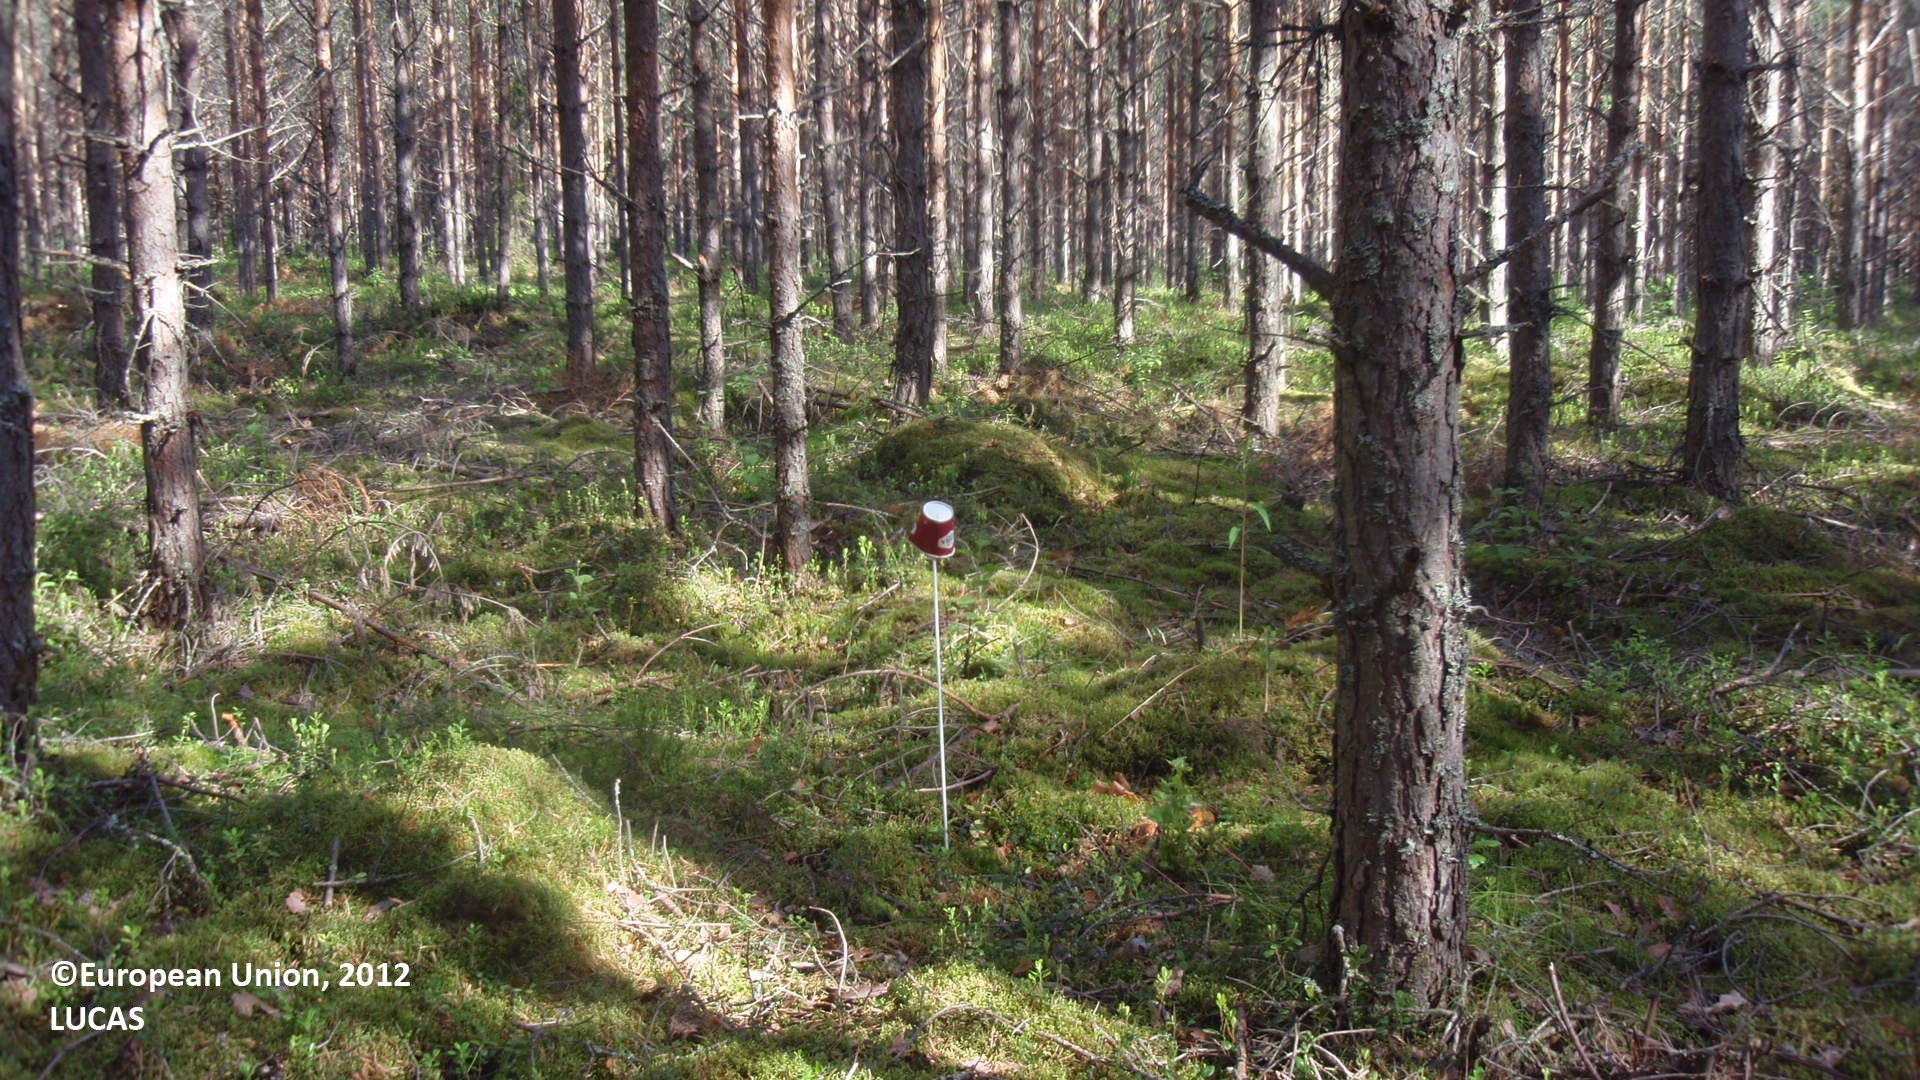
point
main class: Woodland
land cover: Pine dominated coniferous woodland
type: boreal forest
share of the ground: 50 - 75 %
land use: Forestry
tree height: > 5 m
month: July
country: FI
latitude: 61.7766
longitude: 28.2649
